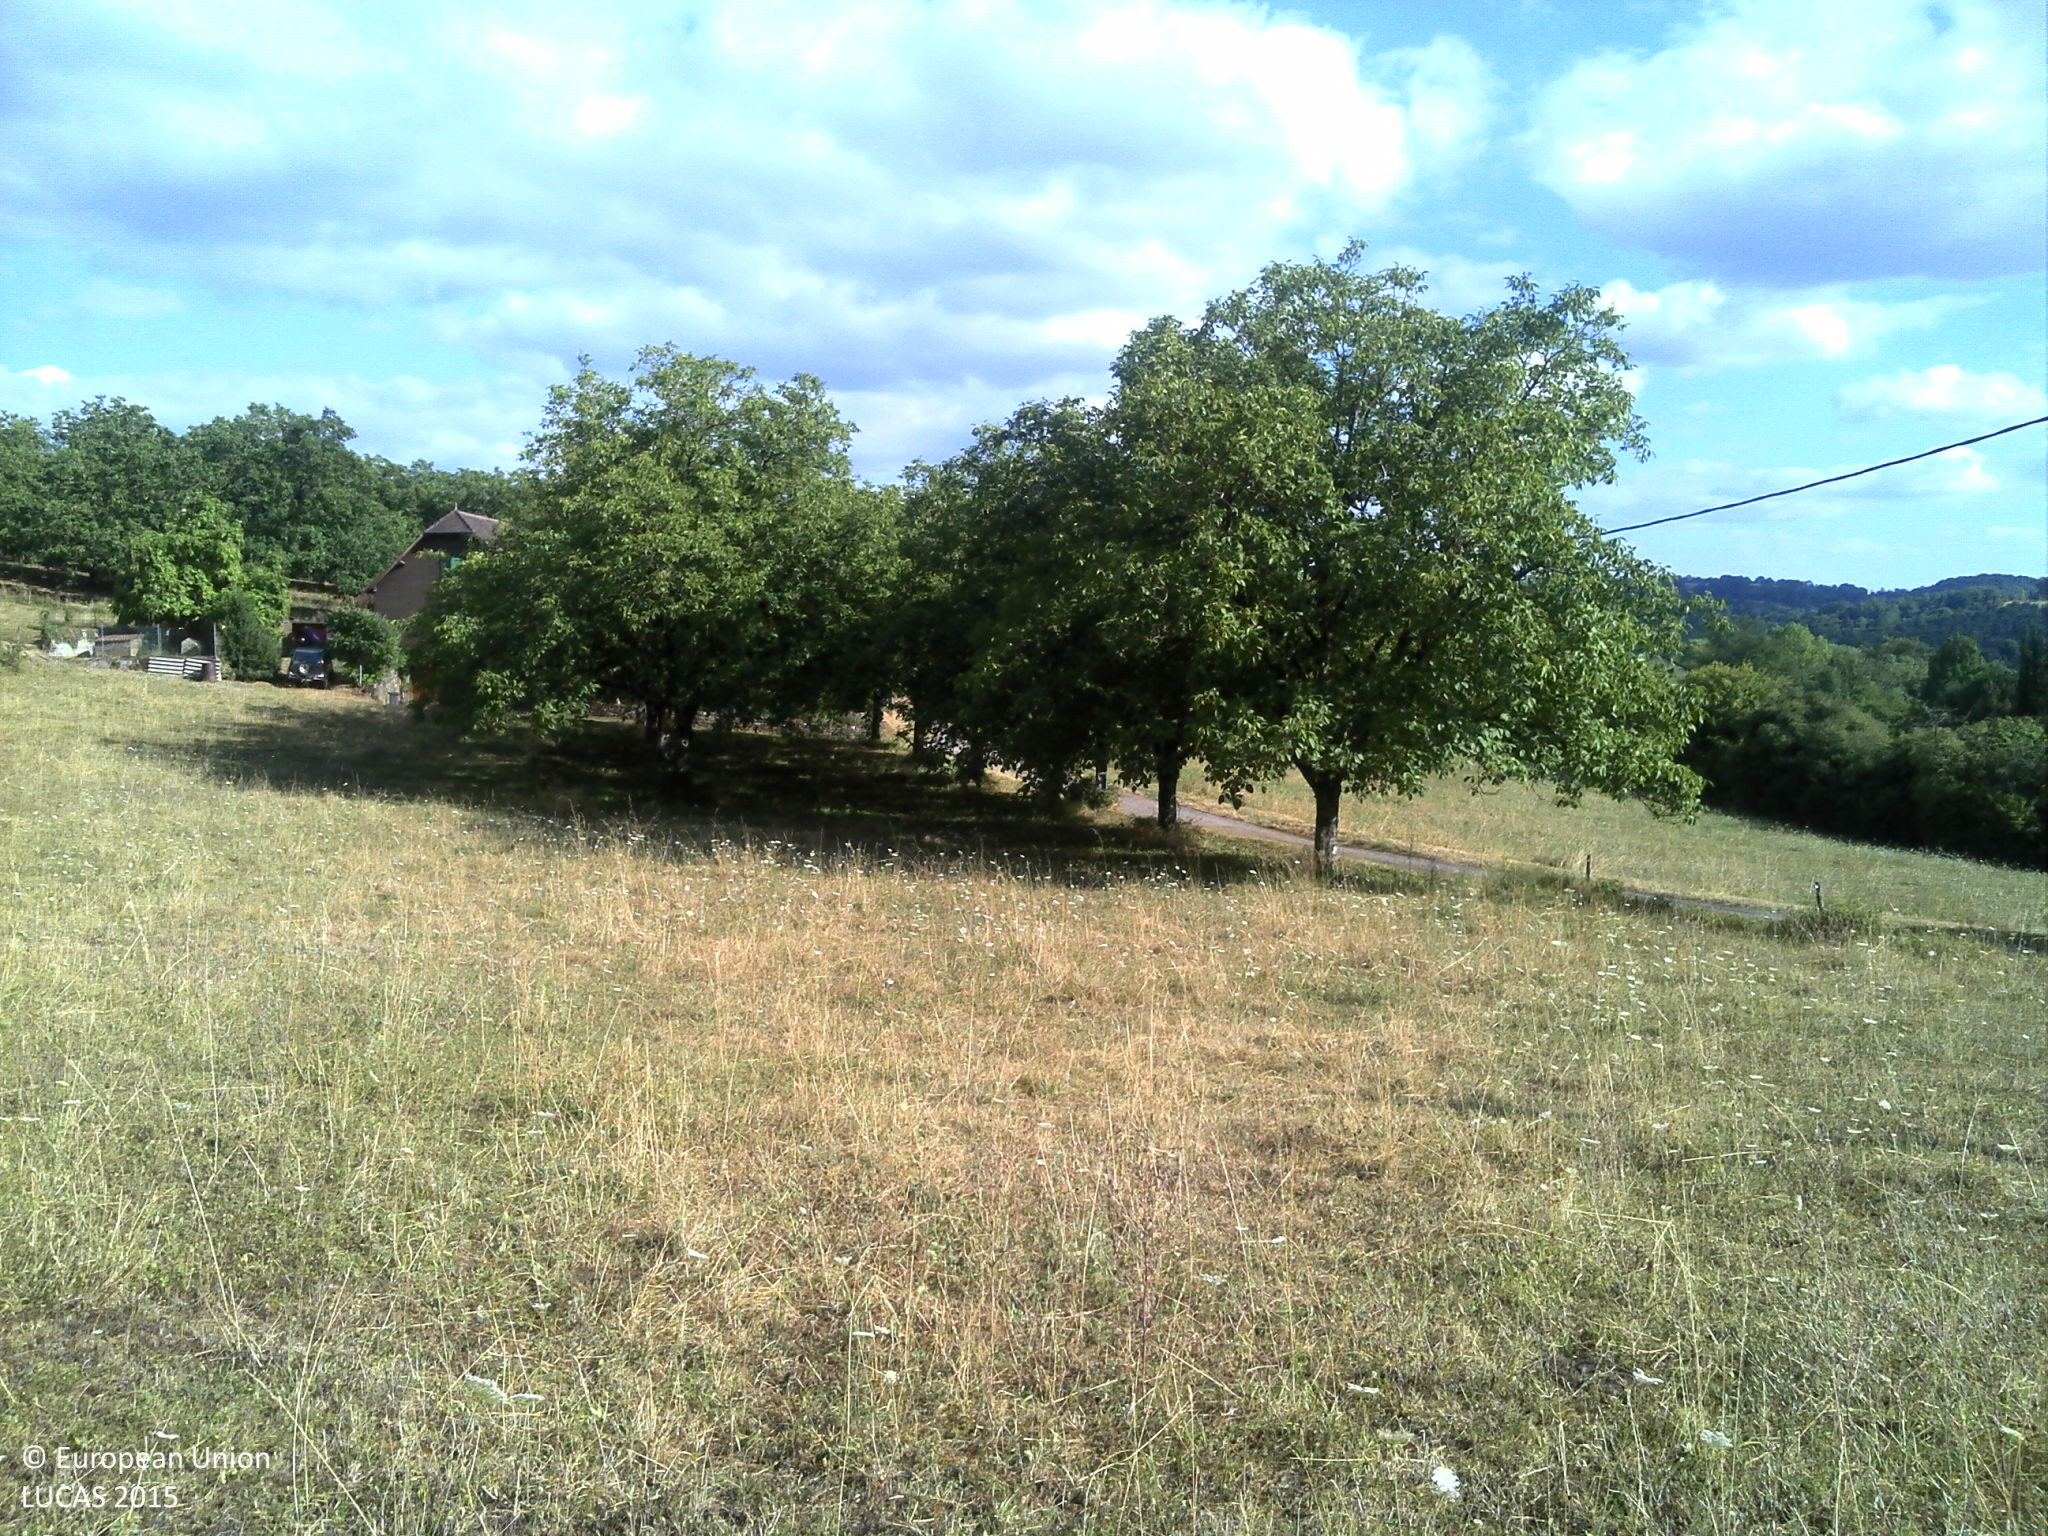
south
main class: Grassland
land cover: Grassland without tree/shrub cover
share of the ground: > 75 %
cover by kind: herbaceous plants 100 %
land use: Agriculture (excluding fallow land and kitchen gardens)
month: July
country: FR
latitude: 45.0230
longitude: 1.8117
